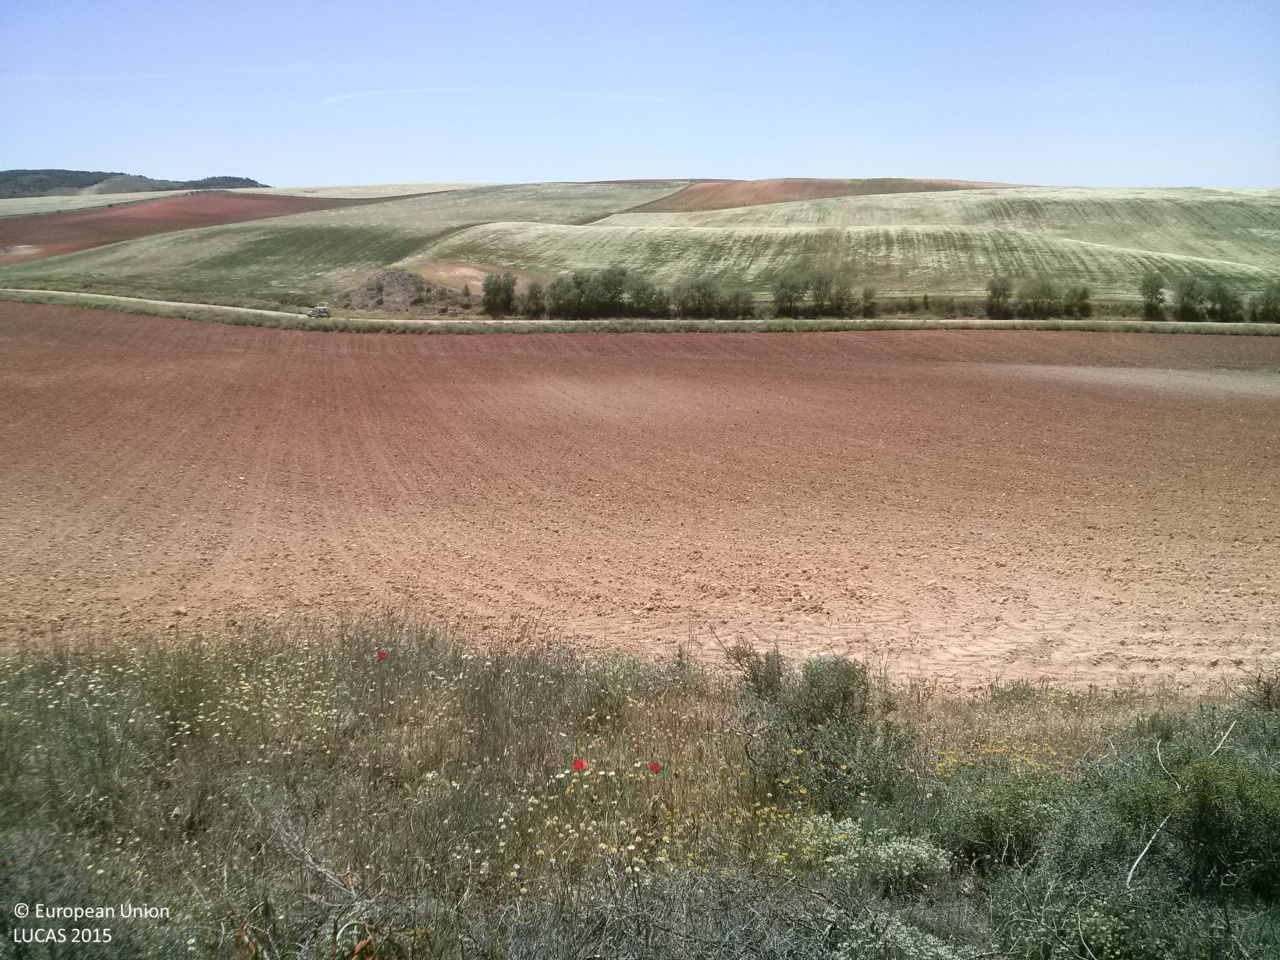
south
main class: Shrubland
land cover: Shrubland without tree cover
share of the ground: 50 - 75 %
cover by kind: shrubs 40 %, herbaceous plants 30 %, unconsolidated bare surface 30 %
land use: Semi-natural and natural areas not in use
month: May
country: ES
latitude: 40.0845
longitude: -2.7939
